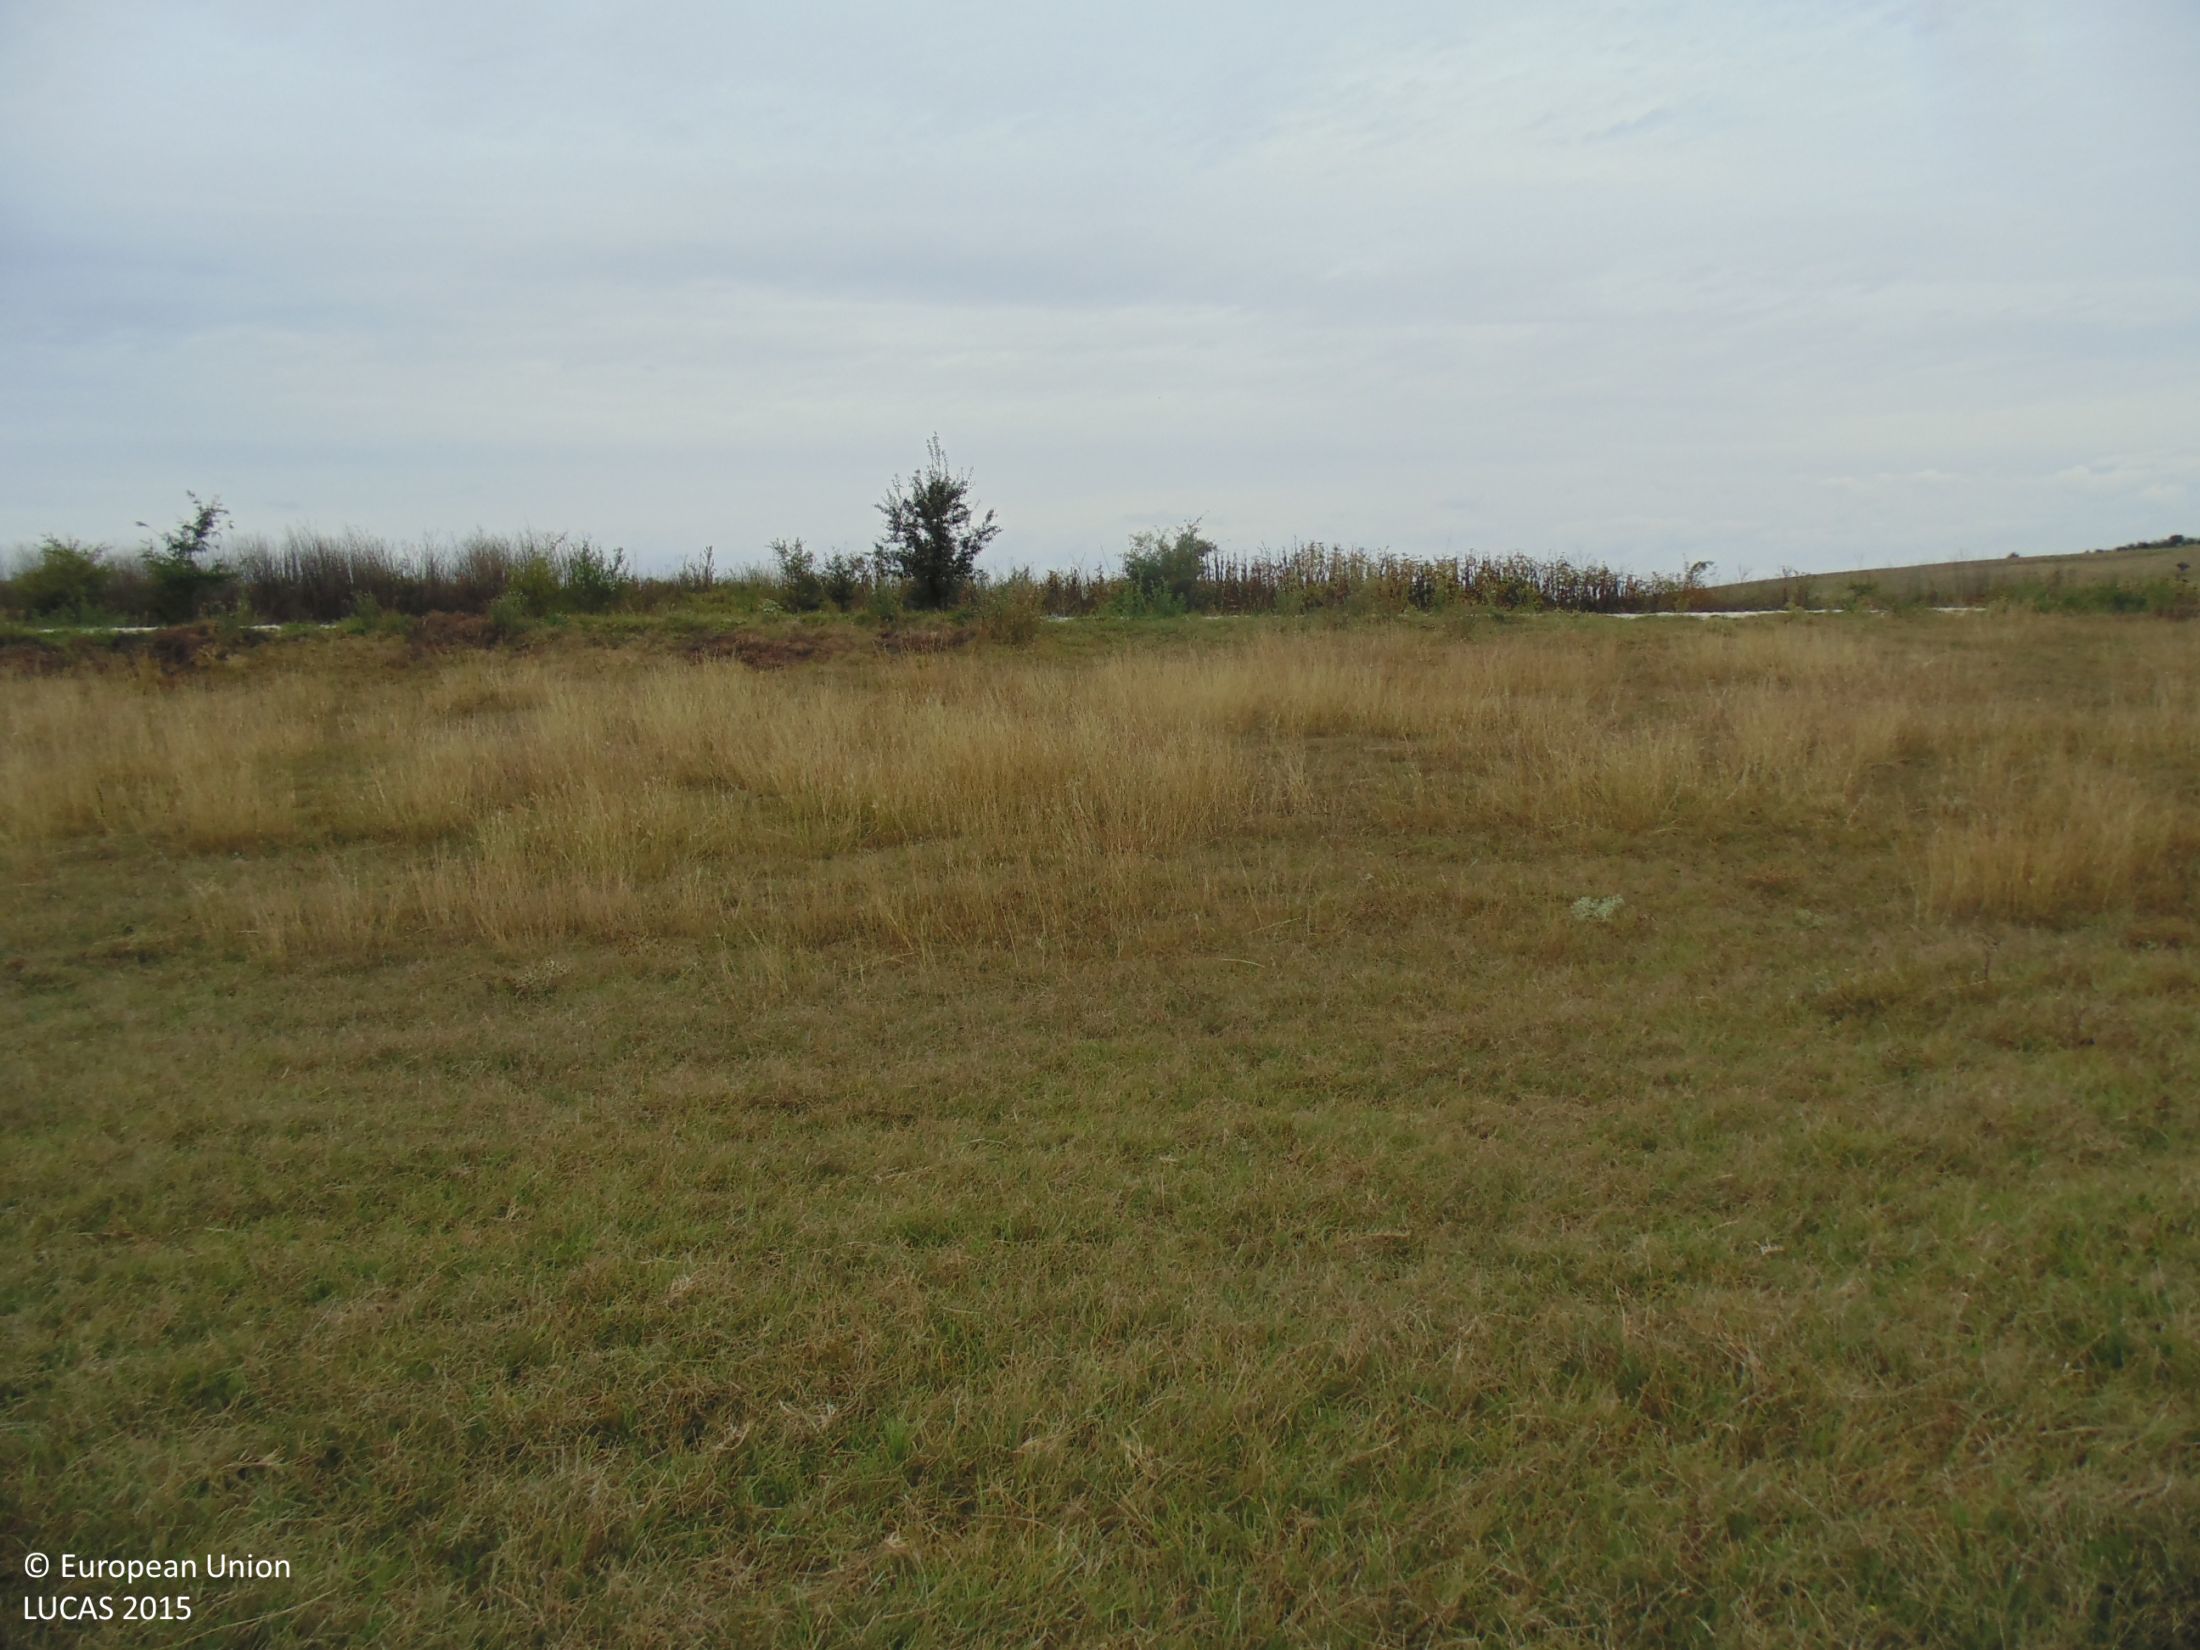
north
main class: Grassland
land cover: Grassland without tree/shrub cover
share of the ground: > 75 %
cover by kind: herbaceous plants 100 %
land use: Agriculture (excluding fallow land and kitchen gardens)
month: September
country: BG
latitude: 43.9586
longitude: 26.9325
